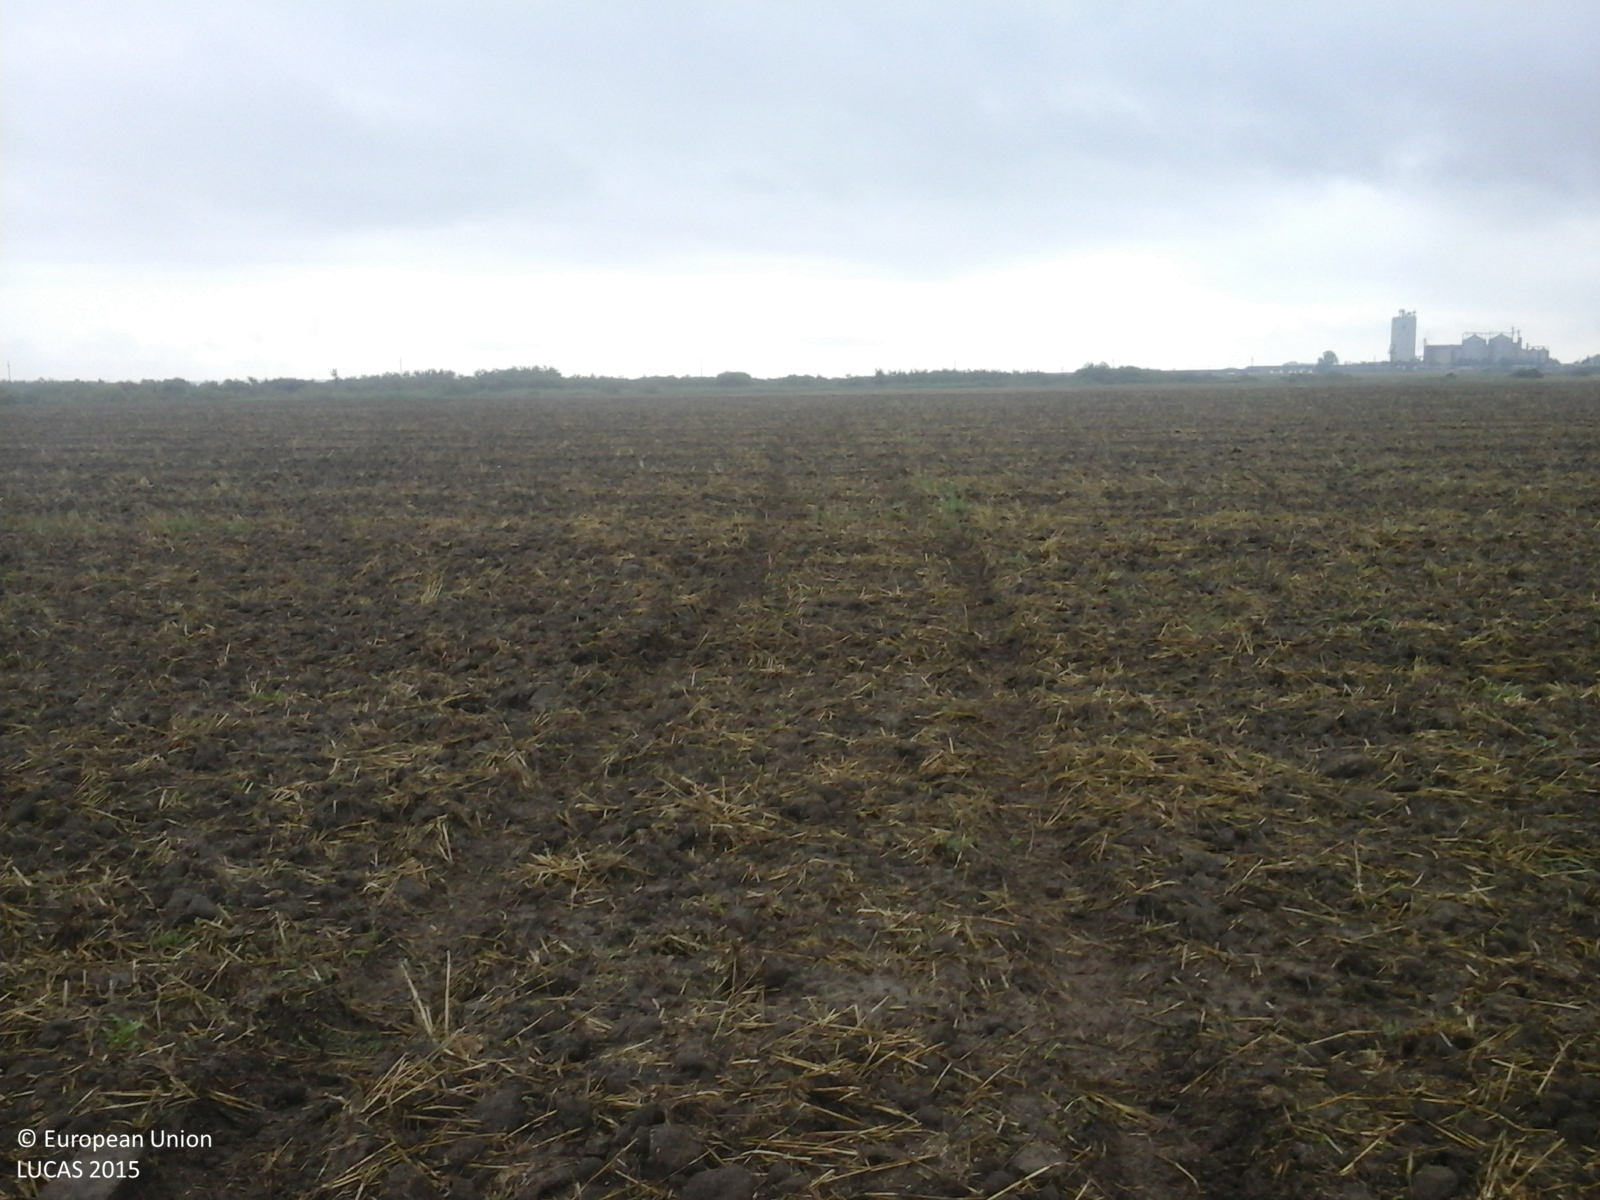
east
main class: Cropland
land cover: Common wheat
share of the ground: < 10 %
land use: Agriculture (excluding fallow land and kitchen gardens)
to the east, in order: Common wheat
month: August
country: RO
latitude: 45.6006
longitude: 21.1701
